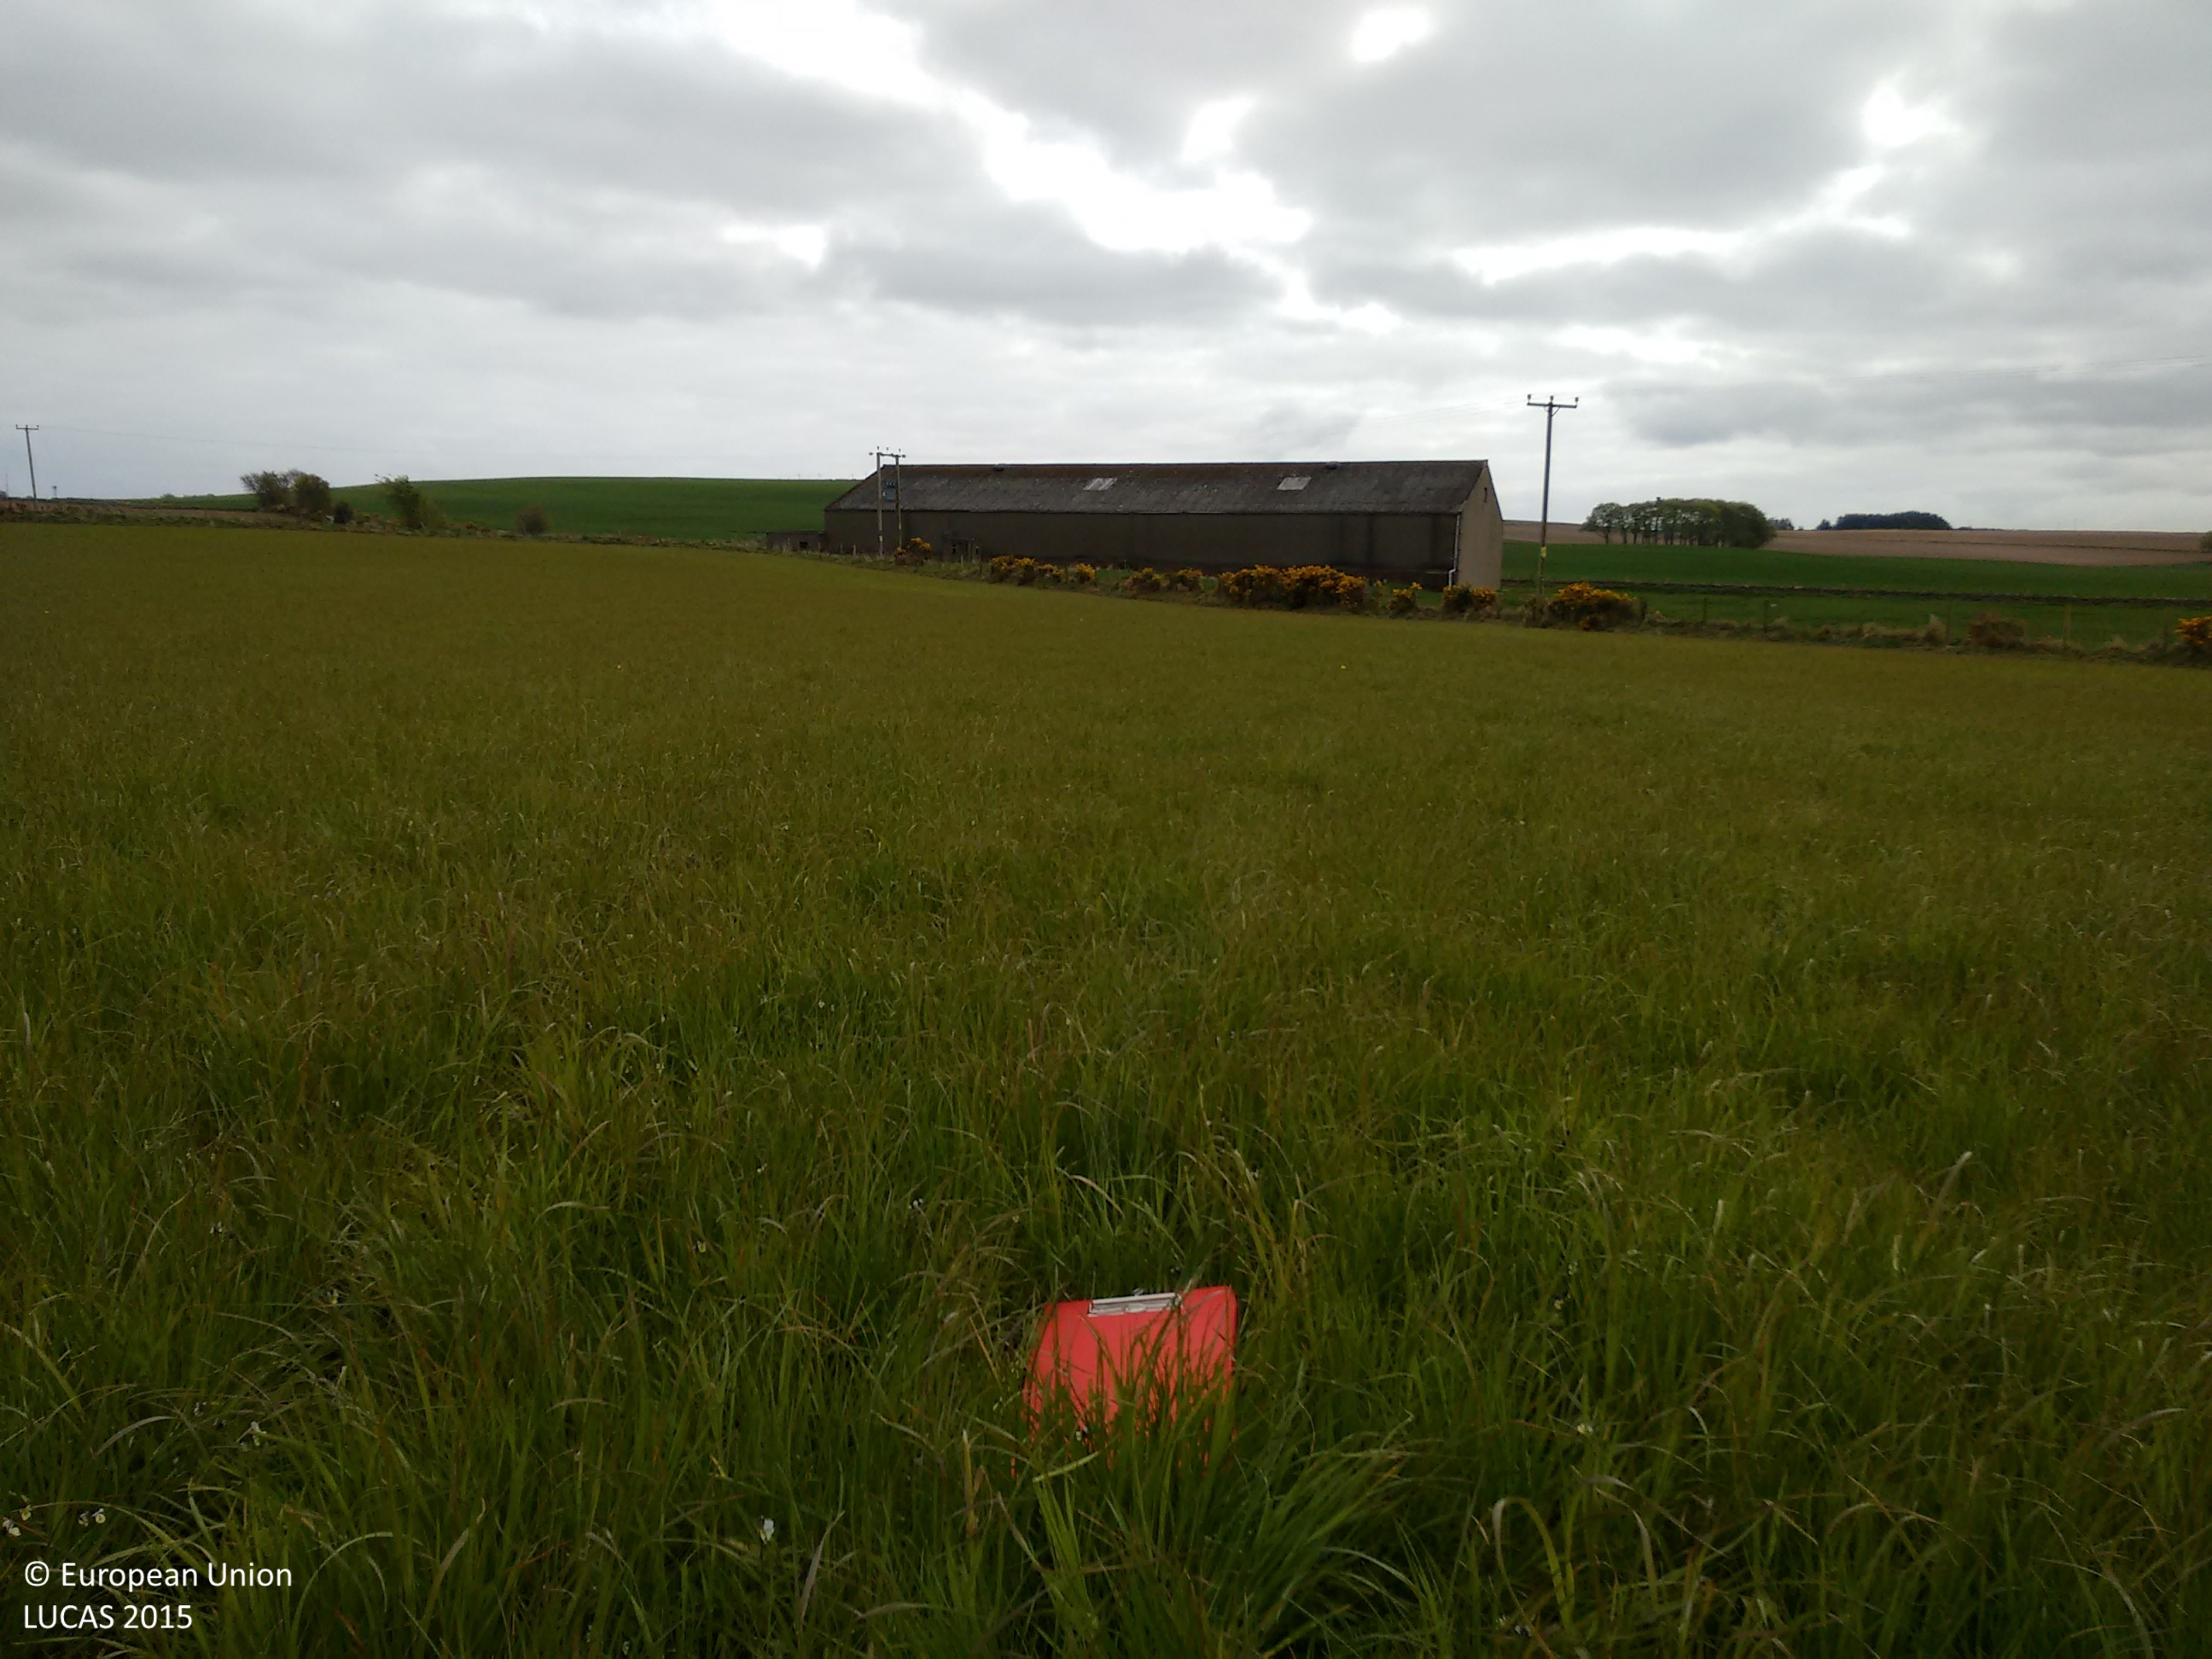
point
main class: Cropland
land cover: Temporary grasslands
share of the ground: > 75 %
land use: Agriculture (excluding fallow land and kitchen gardens)
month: May
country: GB
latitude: 56.6089
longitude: -2.7194
